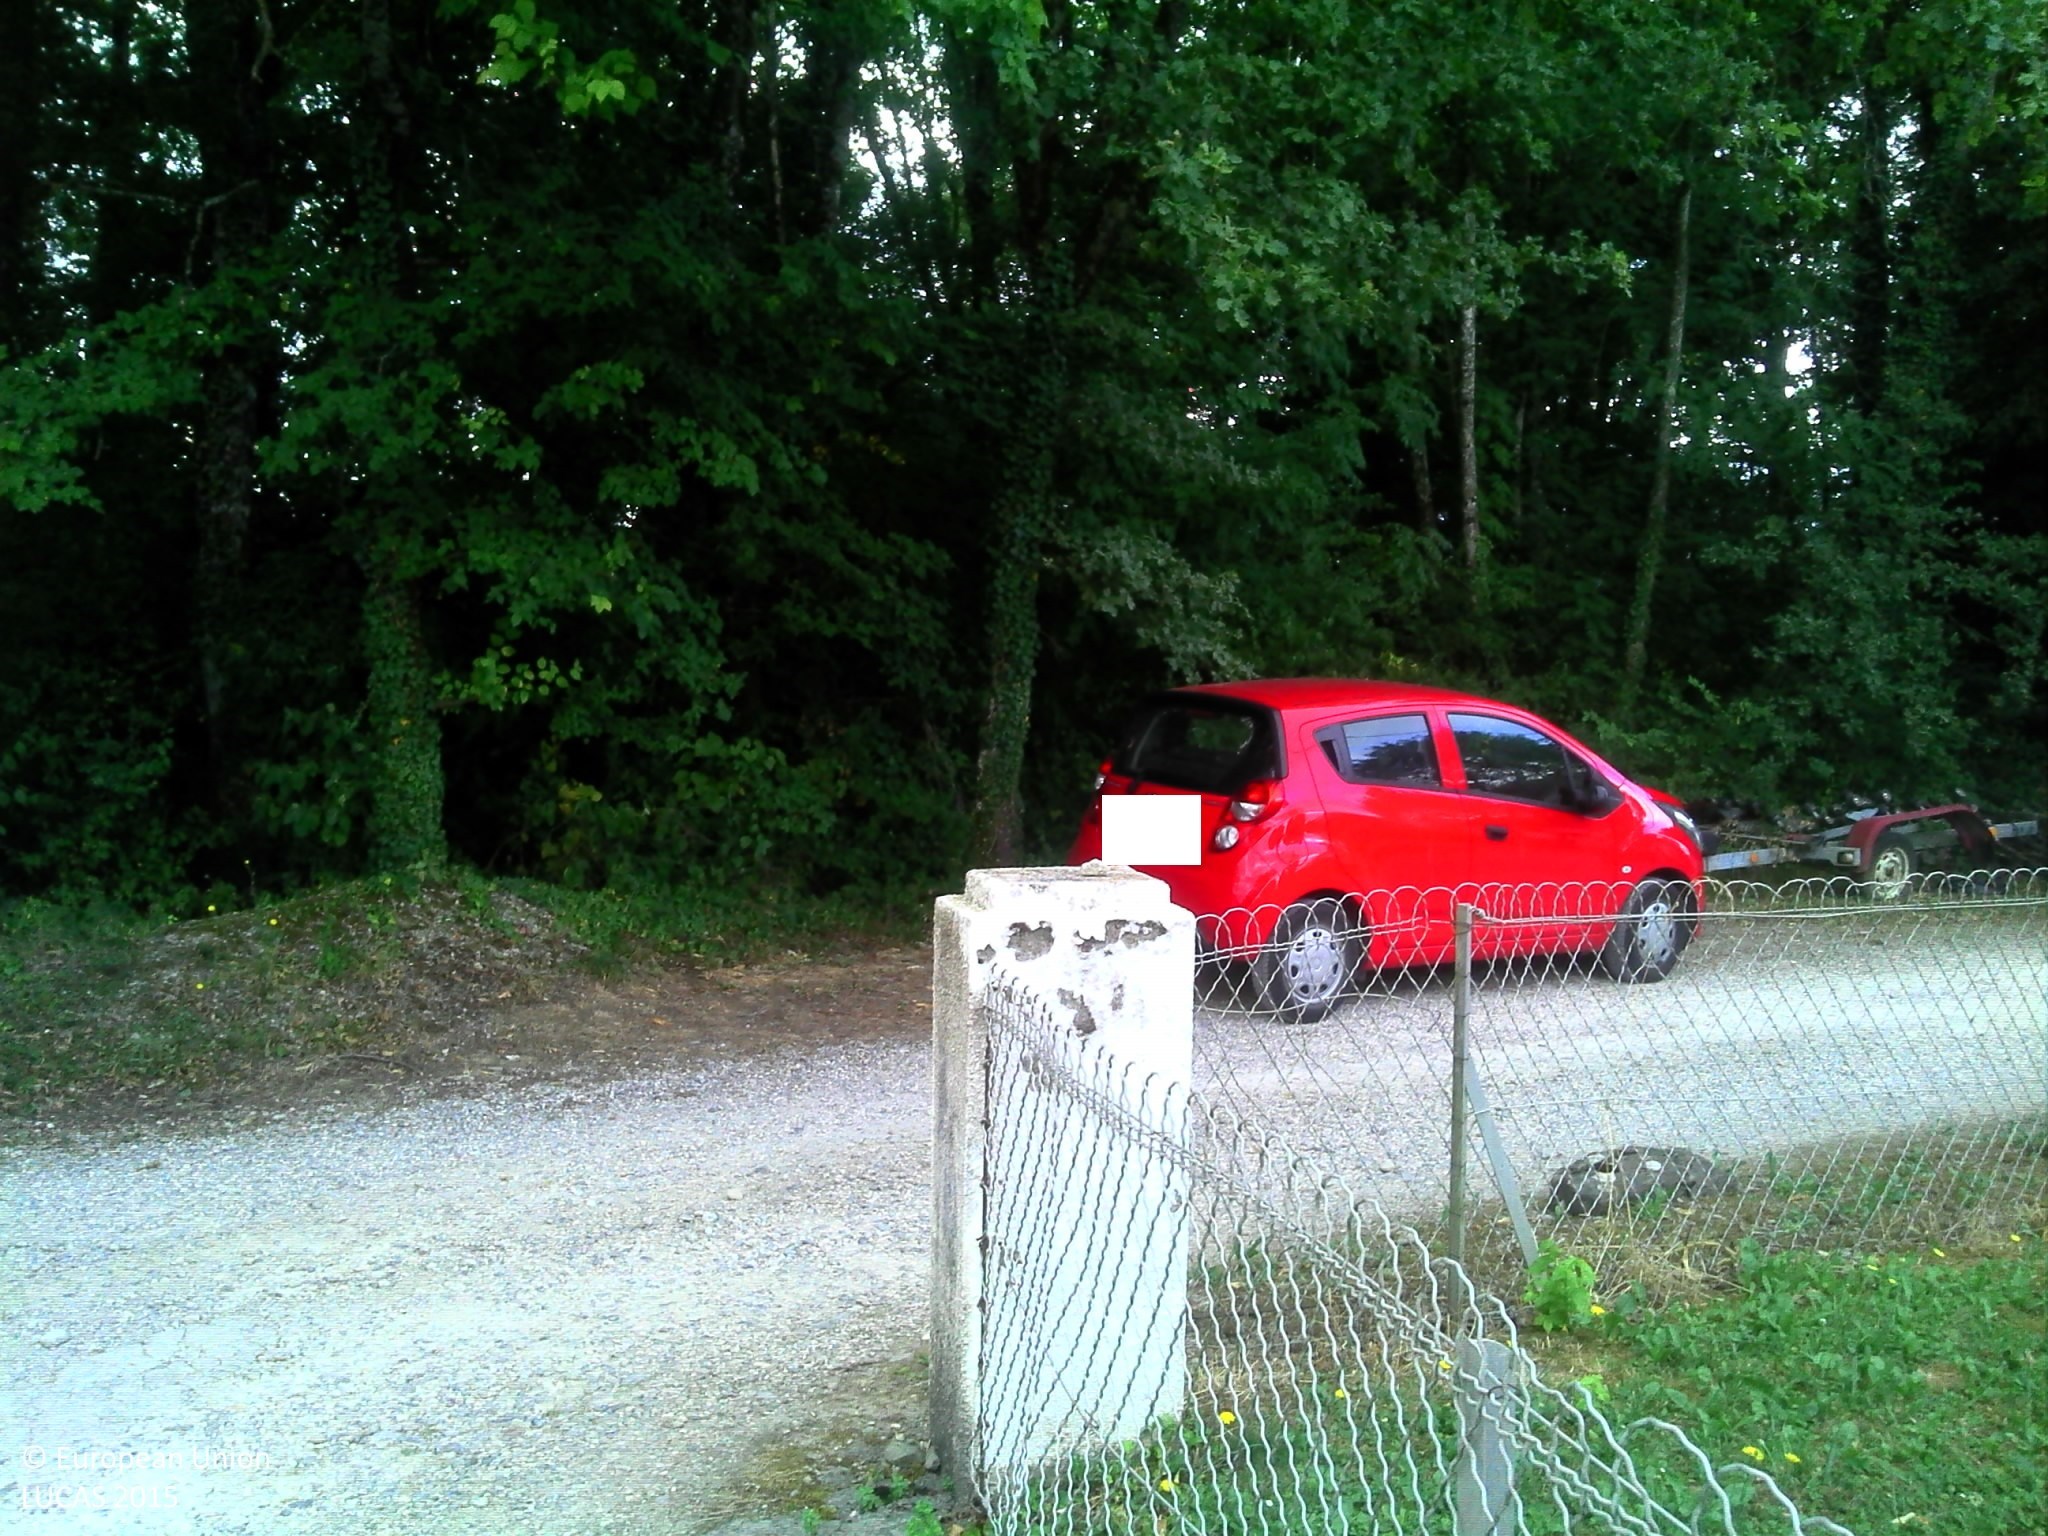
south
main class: Grassland
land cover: Grassland with sparse tree/shrub cover
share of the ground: > 75 %
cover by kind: herbaceous plants 95 %, broadleaved forest trees 5 %
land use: Residential
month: July
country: FR
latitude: 46.1606
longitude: 6.2869
